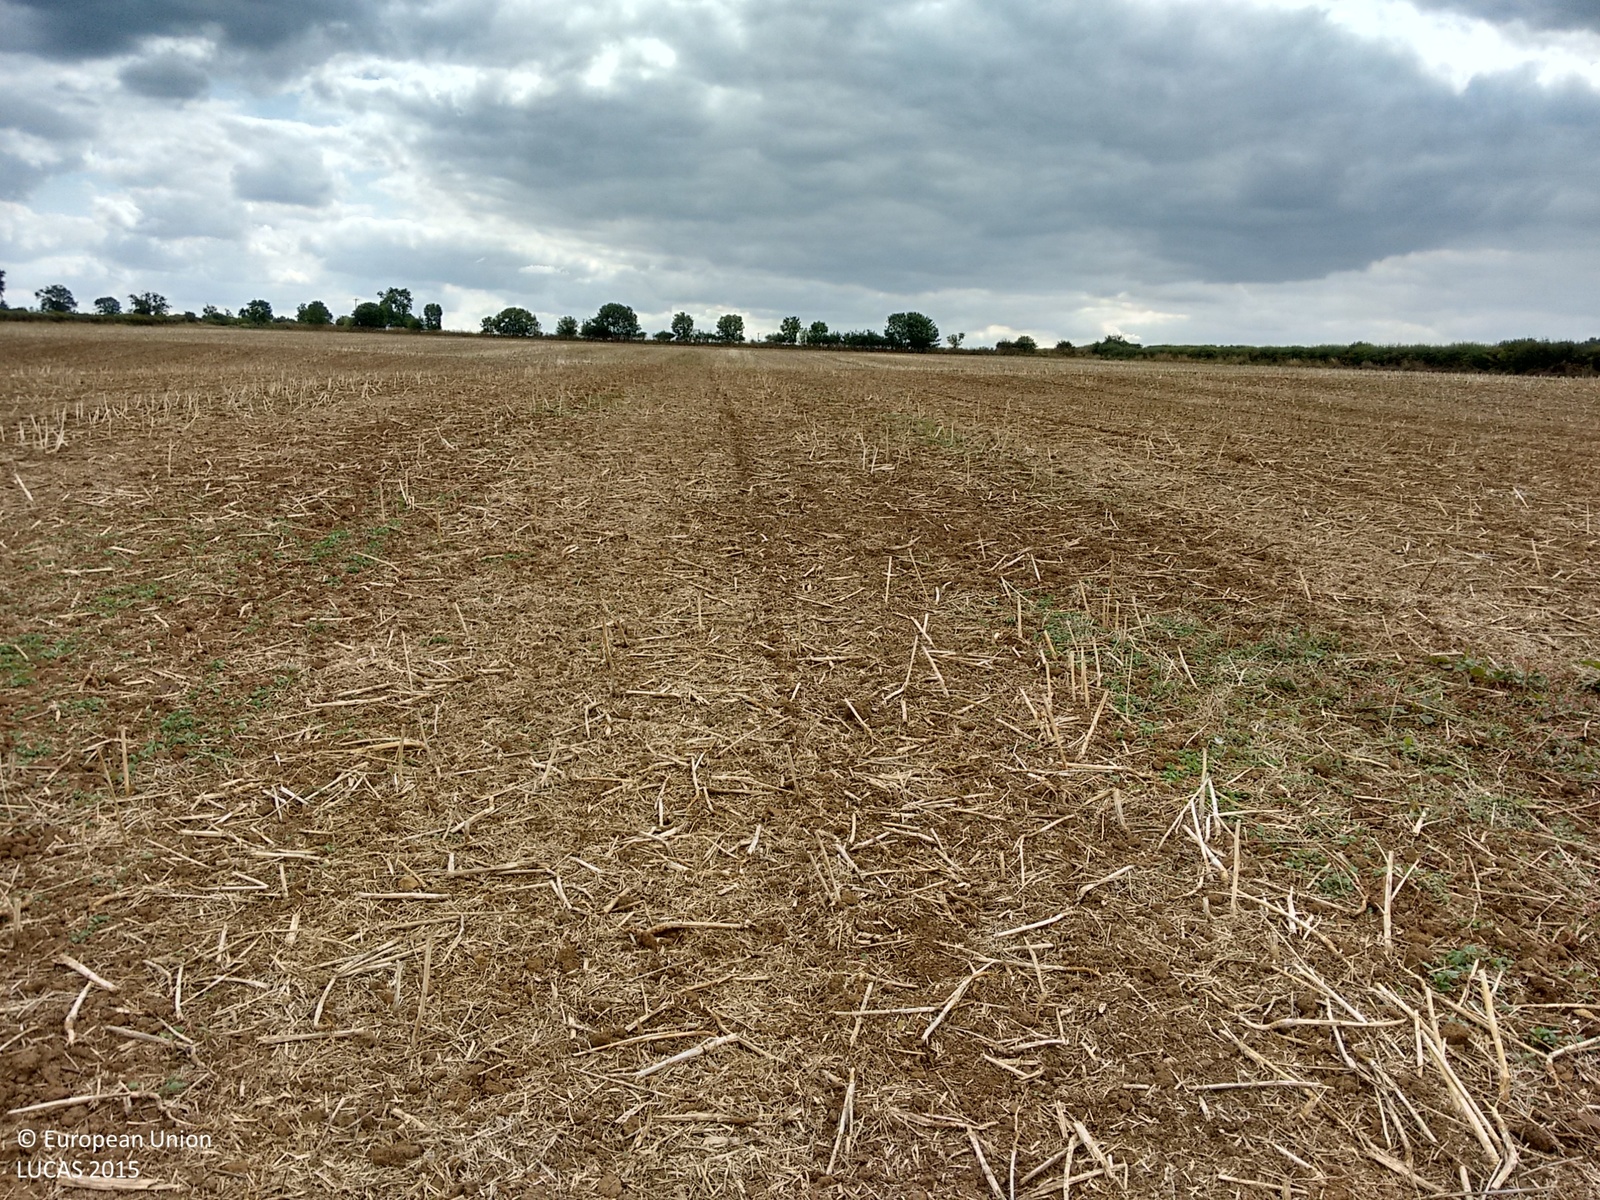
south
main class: Cropland
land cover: Rape and turnip rape
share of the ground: < 10 %
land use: Agriculture (excluding fallow land and kitchen gardens)
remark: Harvested field
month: August
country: GB
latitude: 52.3625
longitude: -0.7167
